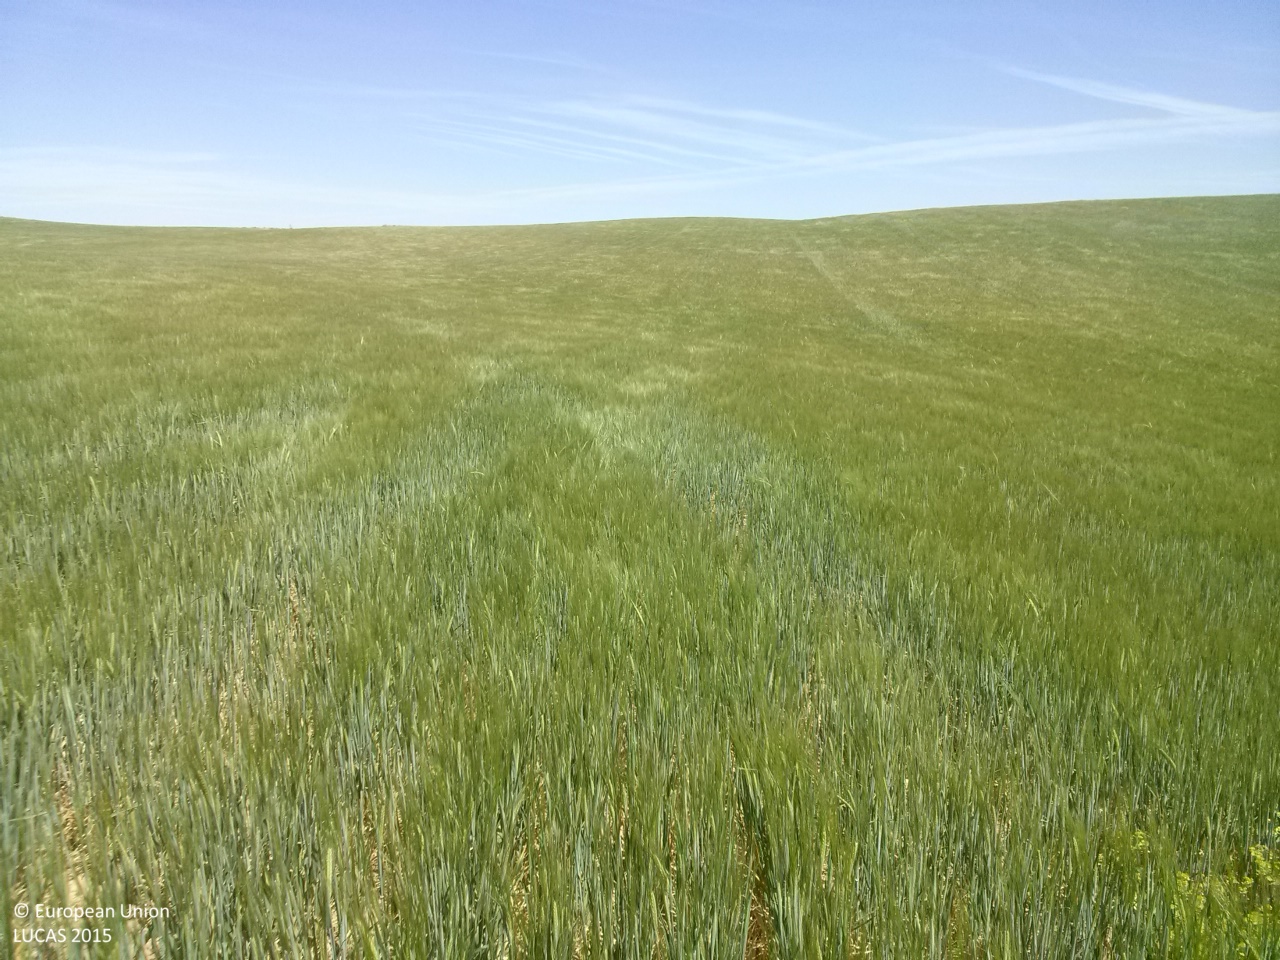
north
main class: Cropland
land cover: Barley
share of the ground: > 75 %
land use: Agriculture (excluding fallow land and kitchen gardens)
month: May
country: ES
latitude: 39.9241
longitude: -2.7617
